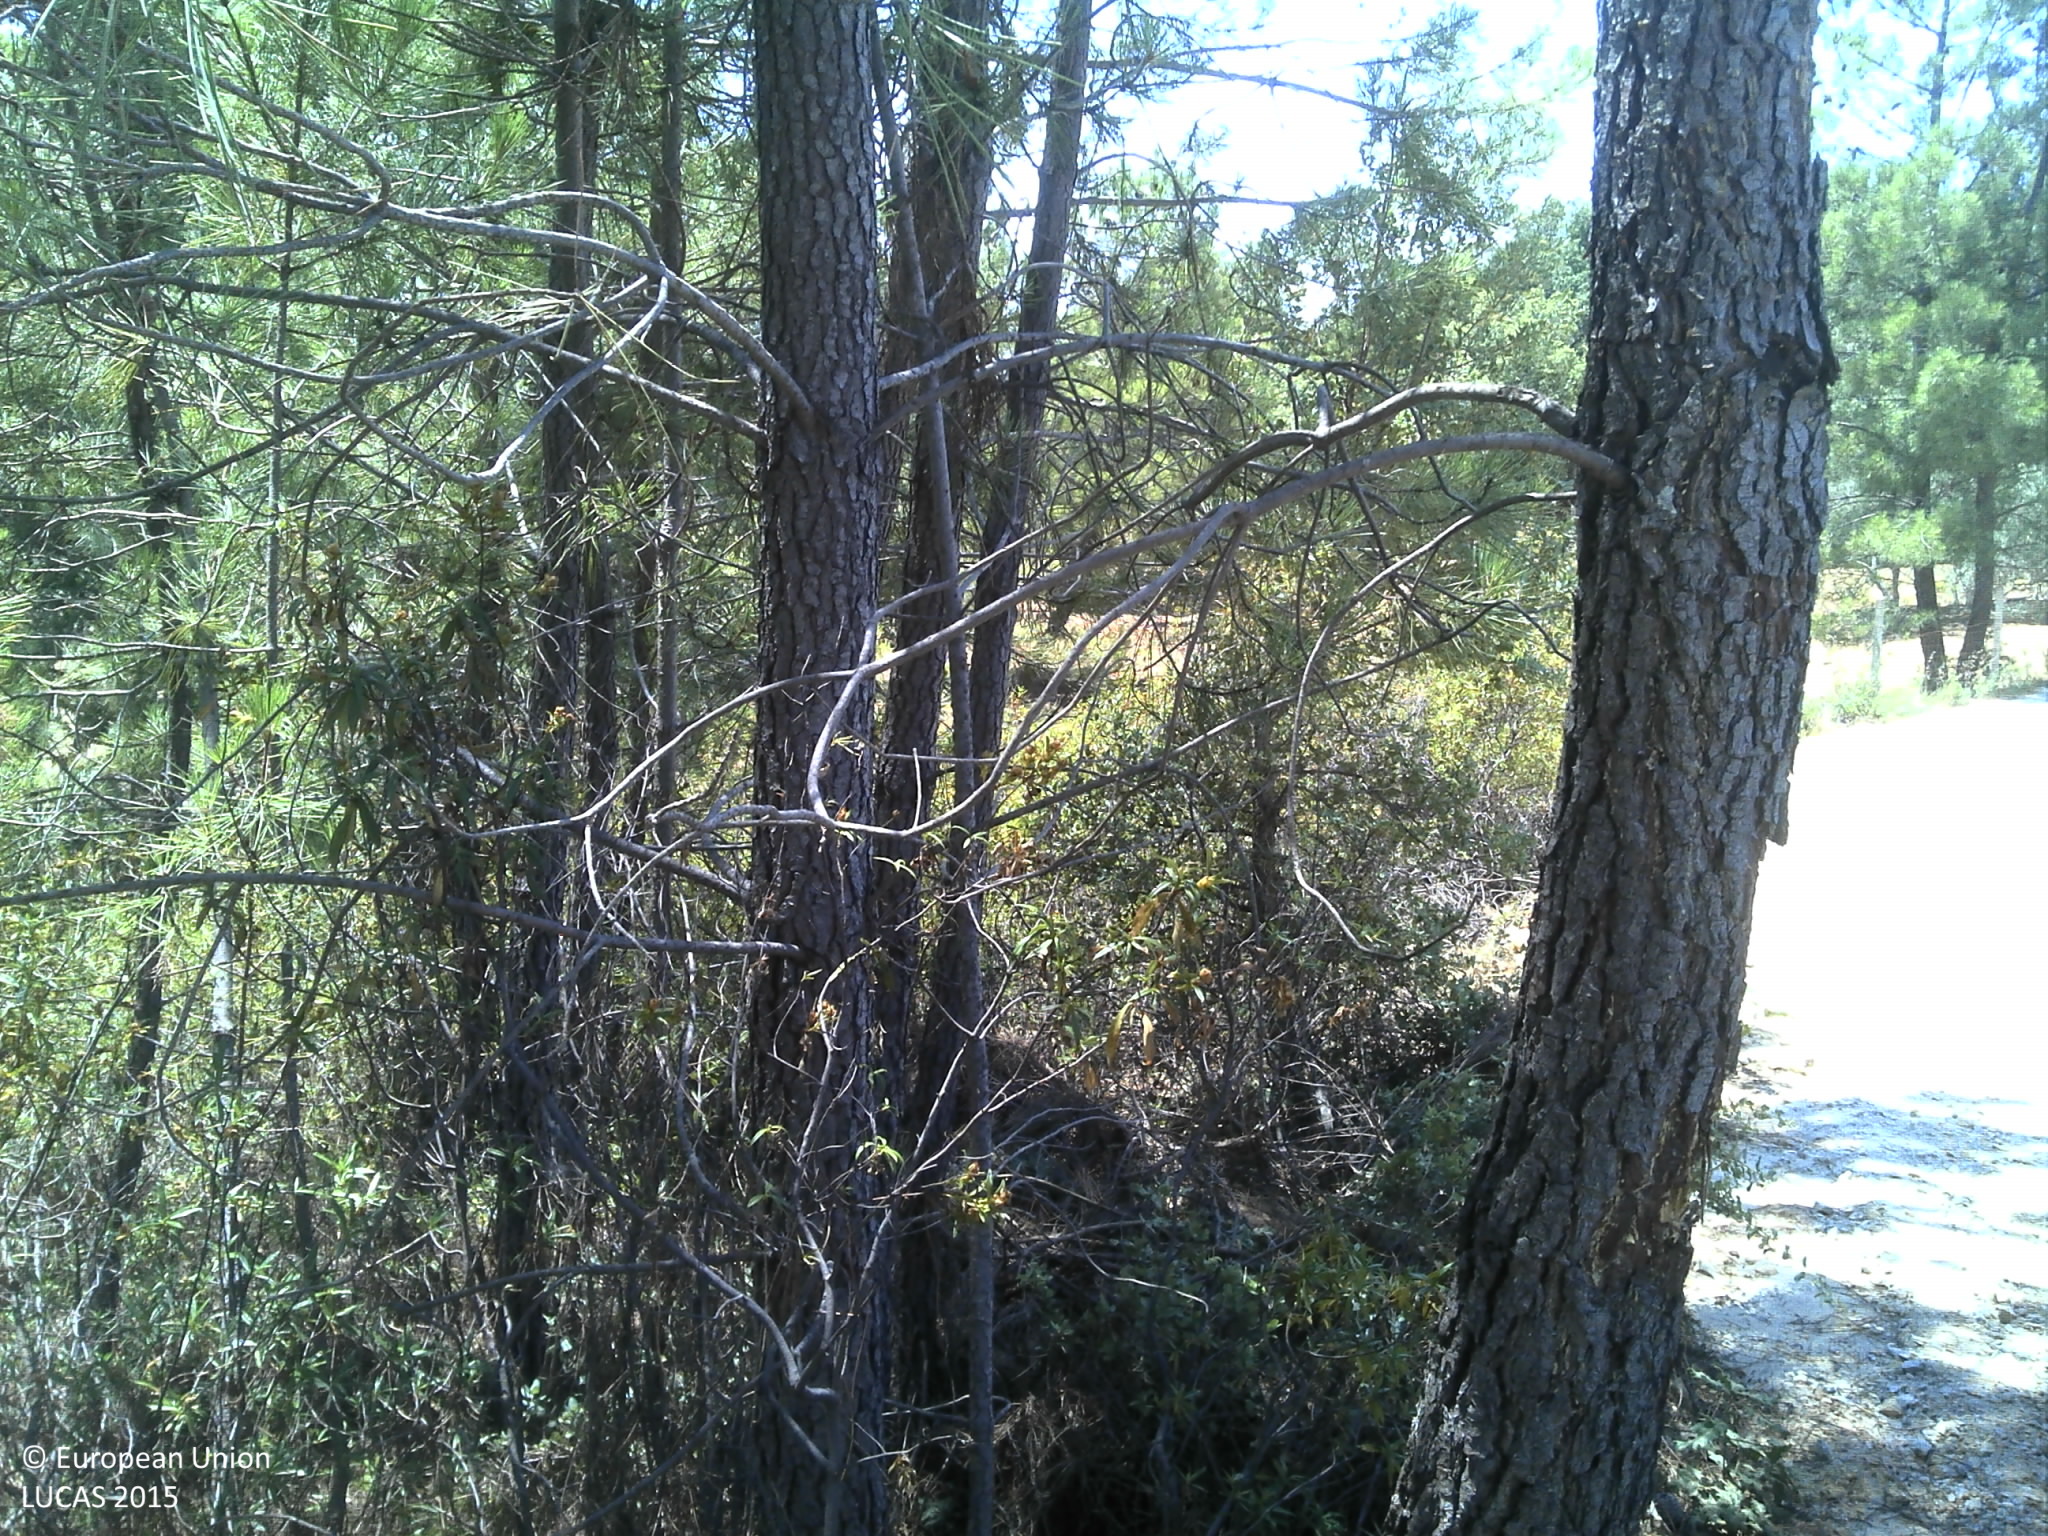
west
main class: Woodland
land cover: Pine dominated coniferous woodland
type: coniferous forest of the mediterranean region
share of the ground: 50 - 75 %
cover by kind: coniferous forest trees 70 %, shrubs 10 %, unconsolidated bare surface 10 %, herbaceous plants 5 %
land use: Forestry
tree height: > 5 m
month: June
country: PT
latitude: 40.0836
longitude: -7.0872
